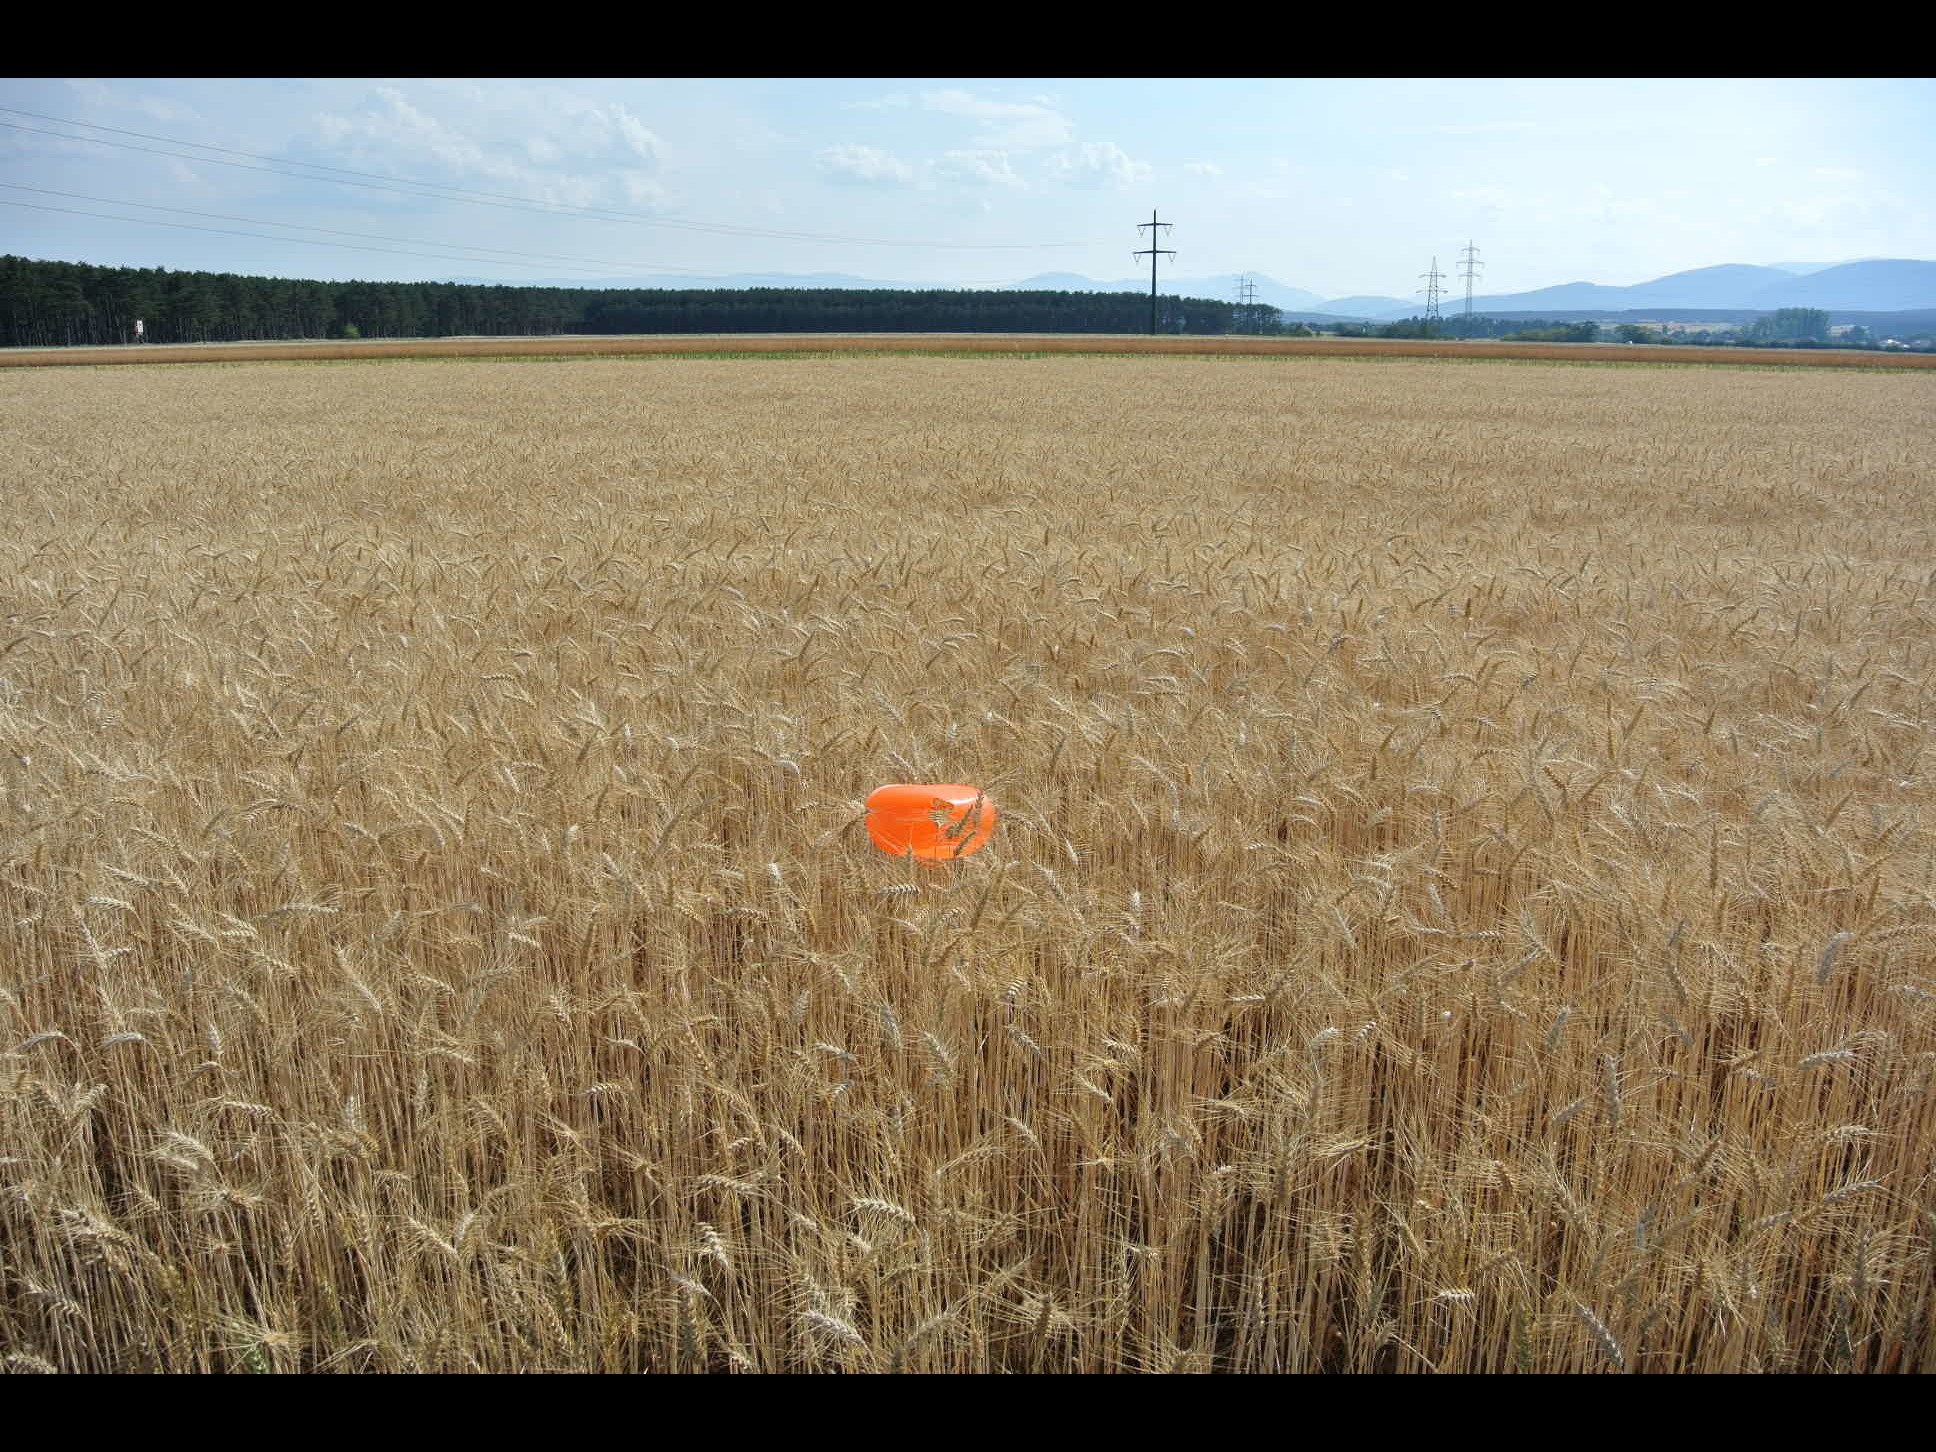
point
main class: Cropland
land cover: Common wheat
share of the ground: > 75 %
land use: Agriculture (excluding fallow land and kitchen gardens)
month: July
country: AT
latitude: 47.7823
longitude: 16.1294
